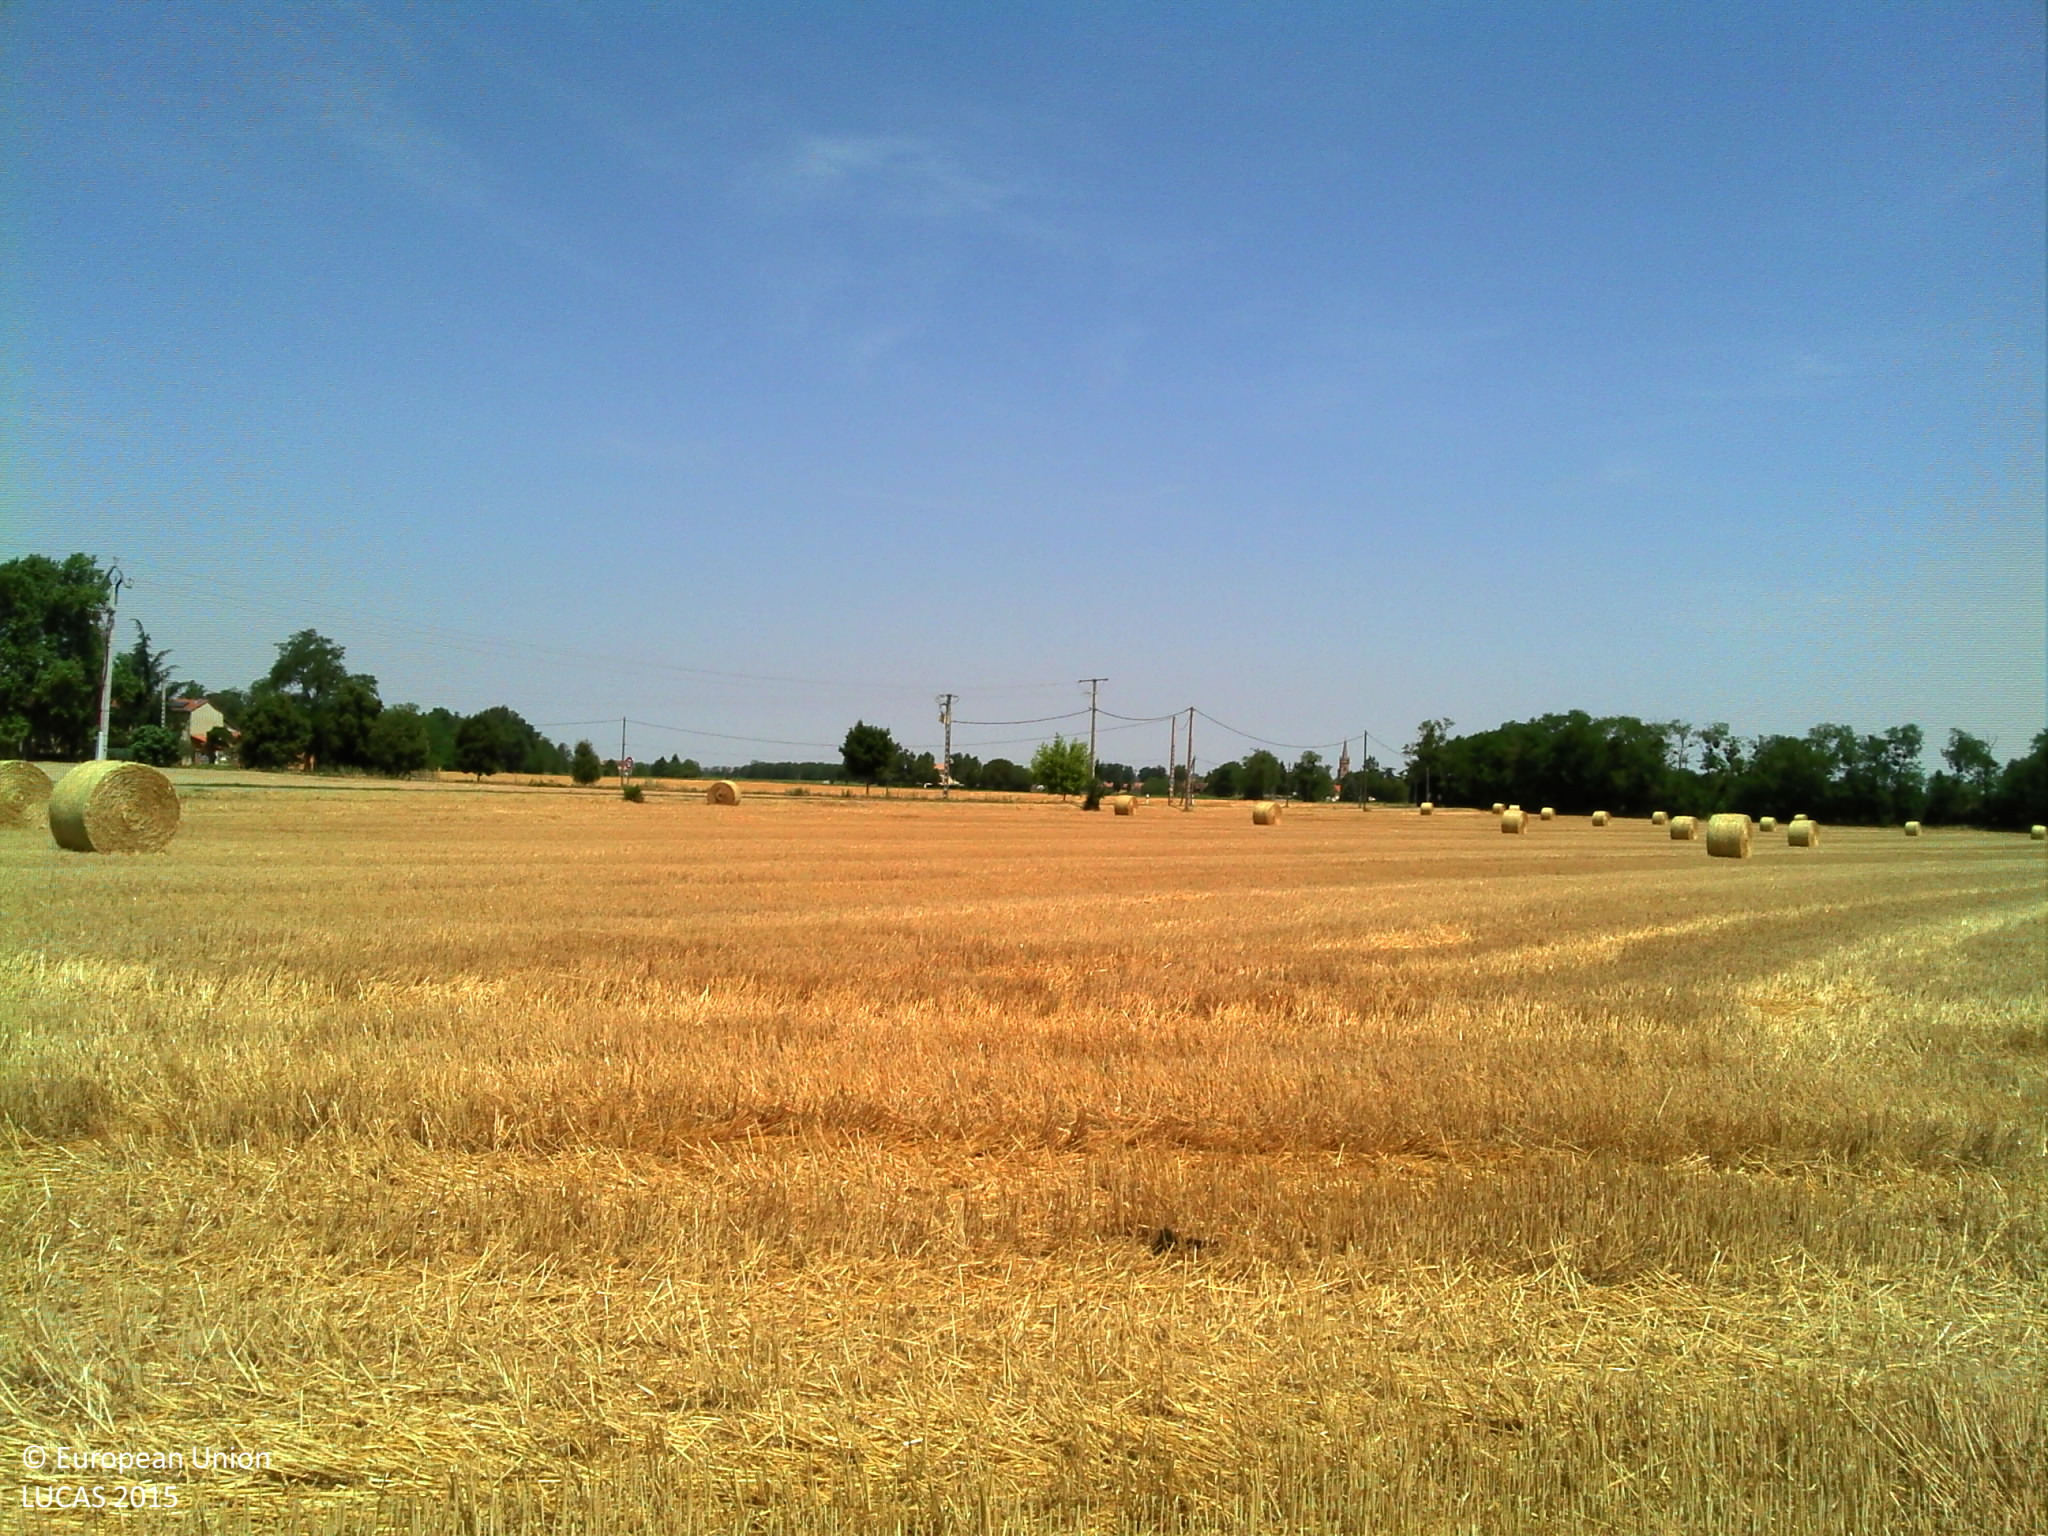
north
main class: Cropland
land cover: Common wheat
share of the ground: > 75 %
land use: Agriculture (excluding fallow land and kitchen gardens)
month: July
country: FR
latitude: 43.1419
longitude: 1.6331
